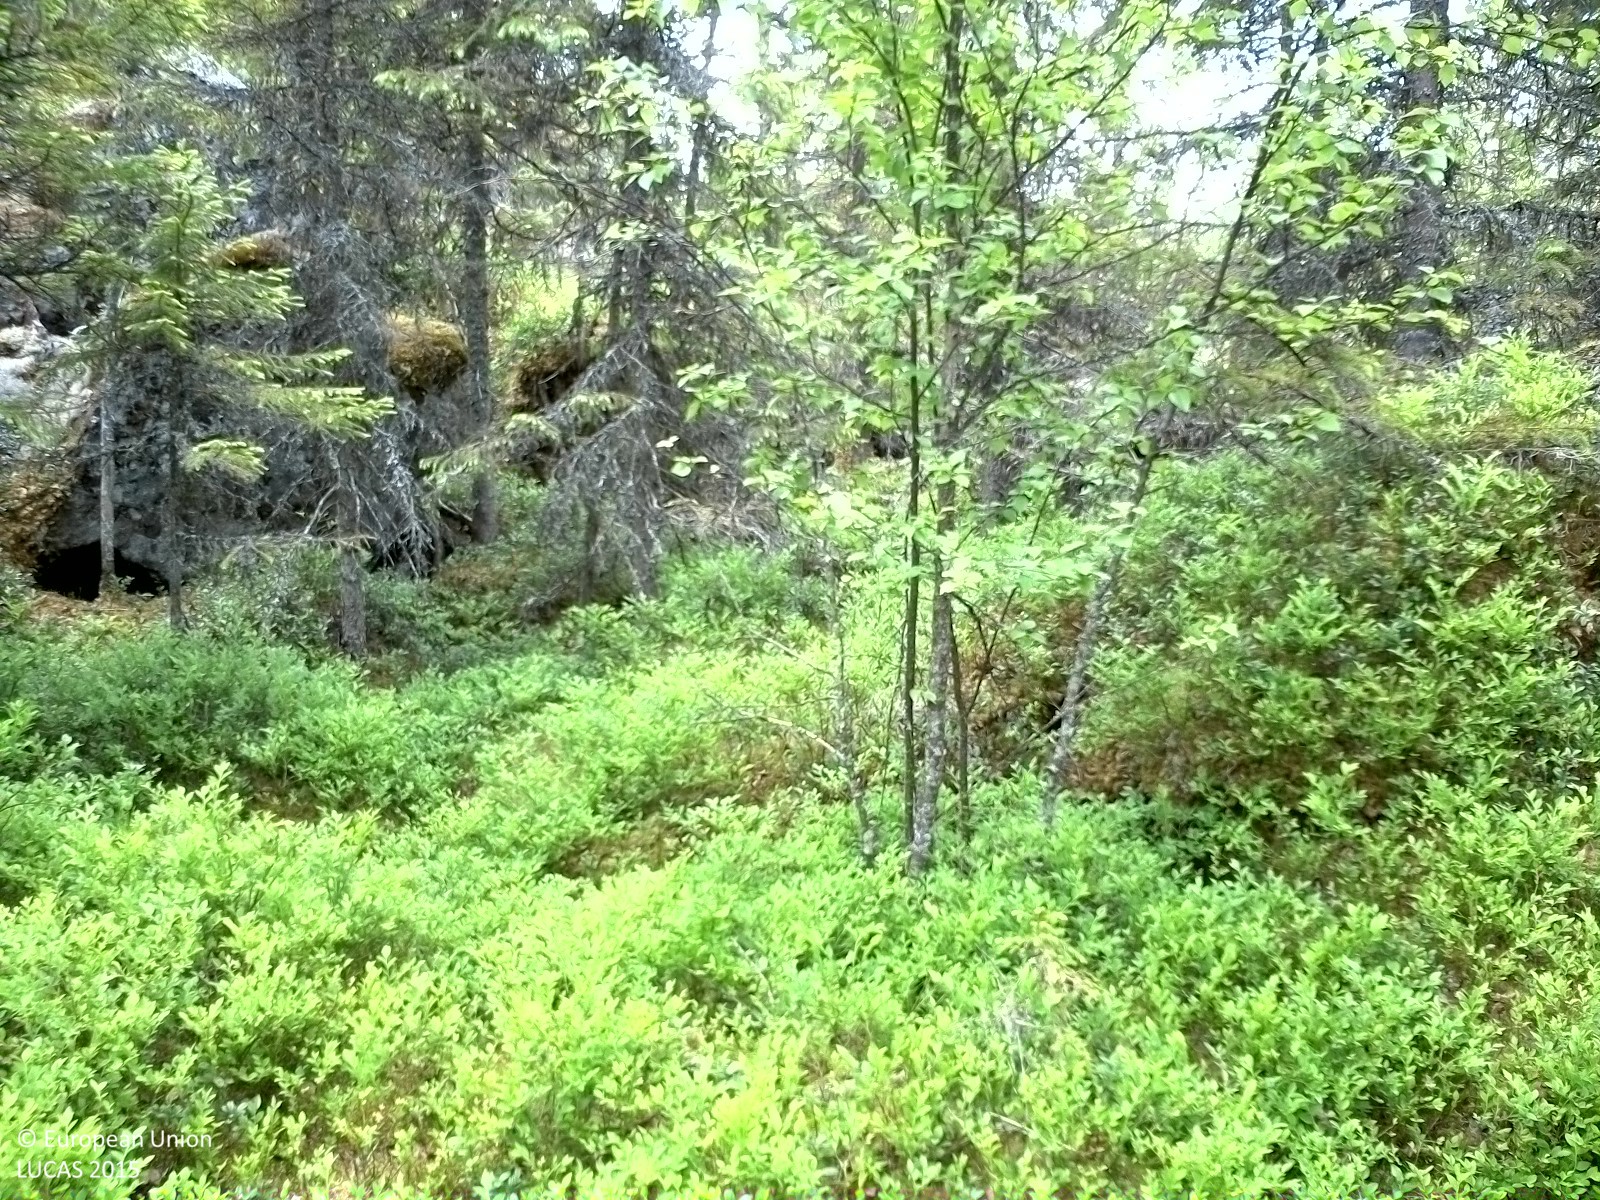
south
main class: Woodland
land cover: Spruce dominated coniferous woodland
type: boreal forest
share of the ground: 25 - 50 %
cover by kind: coniferous forest trees 45 %, shrubs 45 %, broadleaved forest trees 5 %, herbaceous plants 5 %
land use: Forestry
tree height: > 5 m
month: June
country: SE
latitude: 62.1224
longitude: 16.2115
